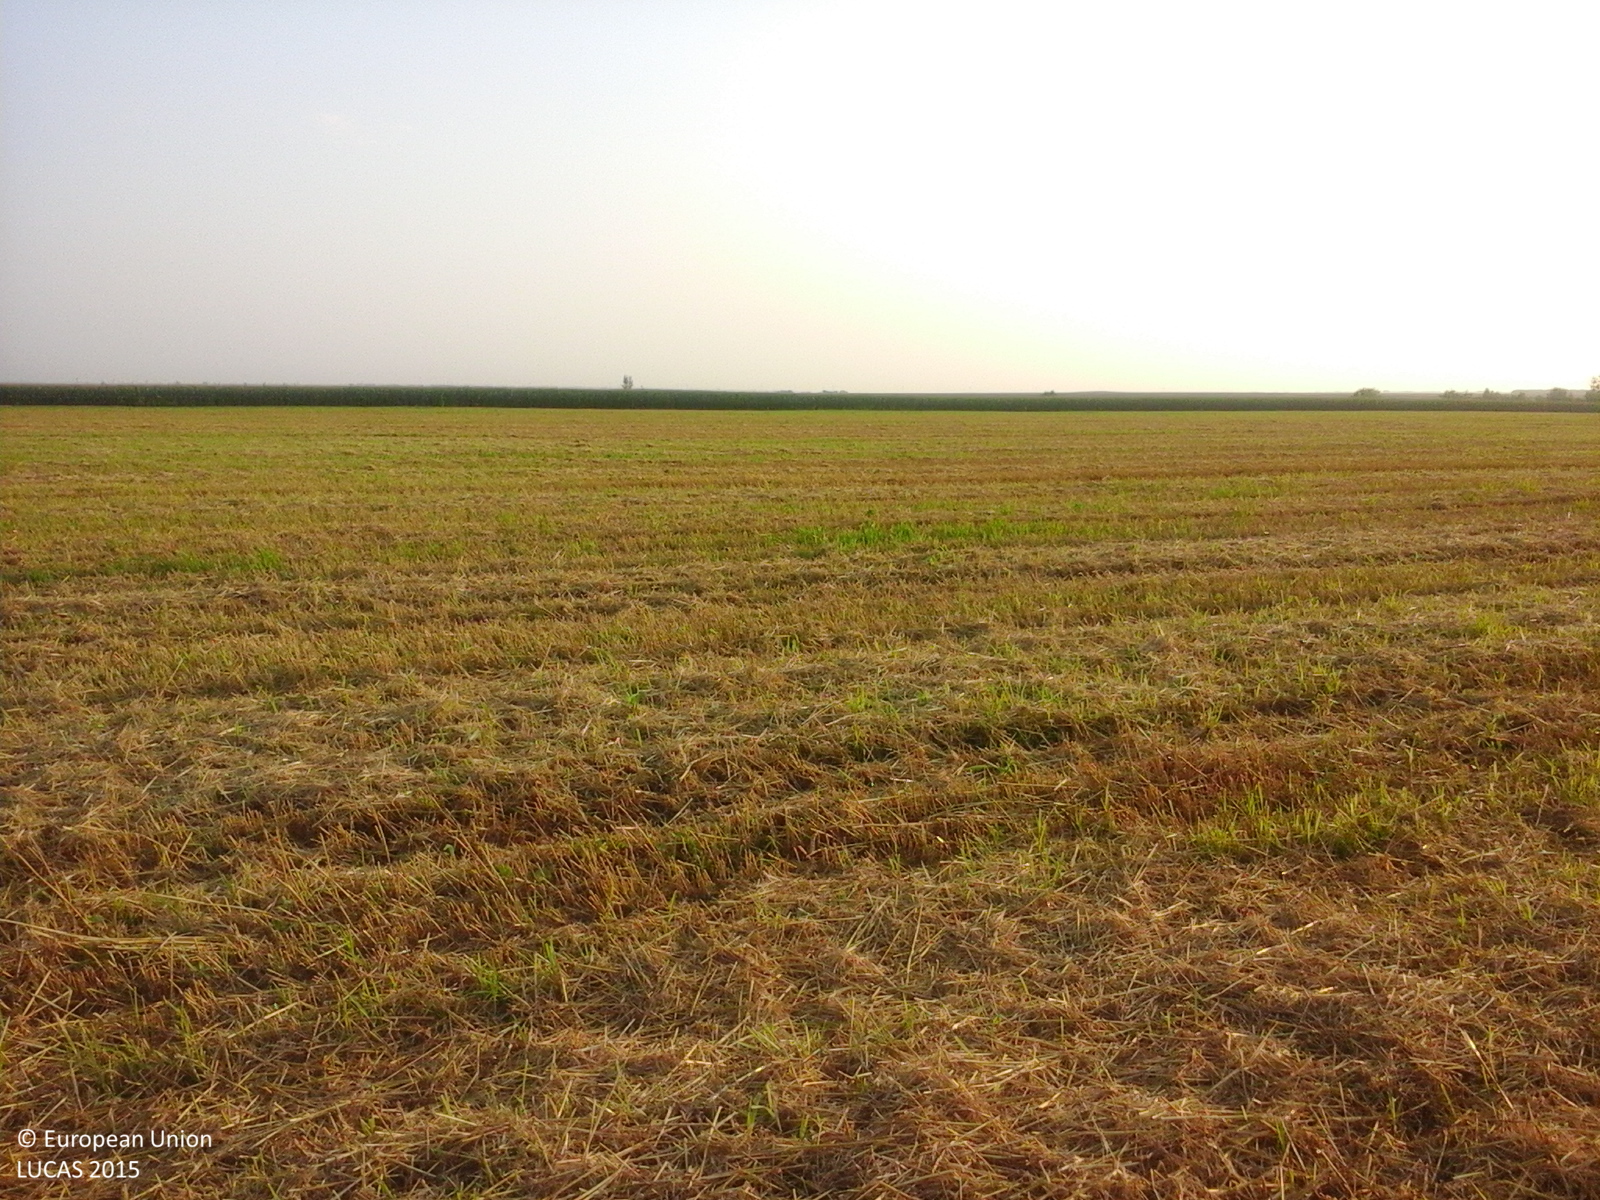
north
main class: Cropland
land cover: Common wheat
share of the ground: 10 - 25 %
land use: Agriculture (excluding fallow land and kitchen gardens)
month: July
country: RO
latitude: 44.5957
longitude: 27.4128
